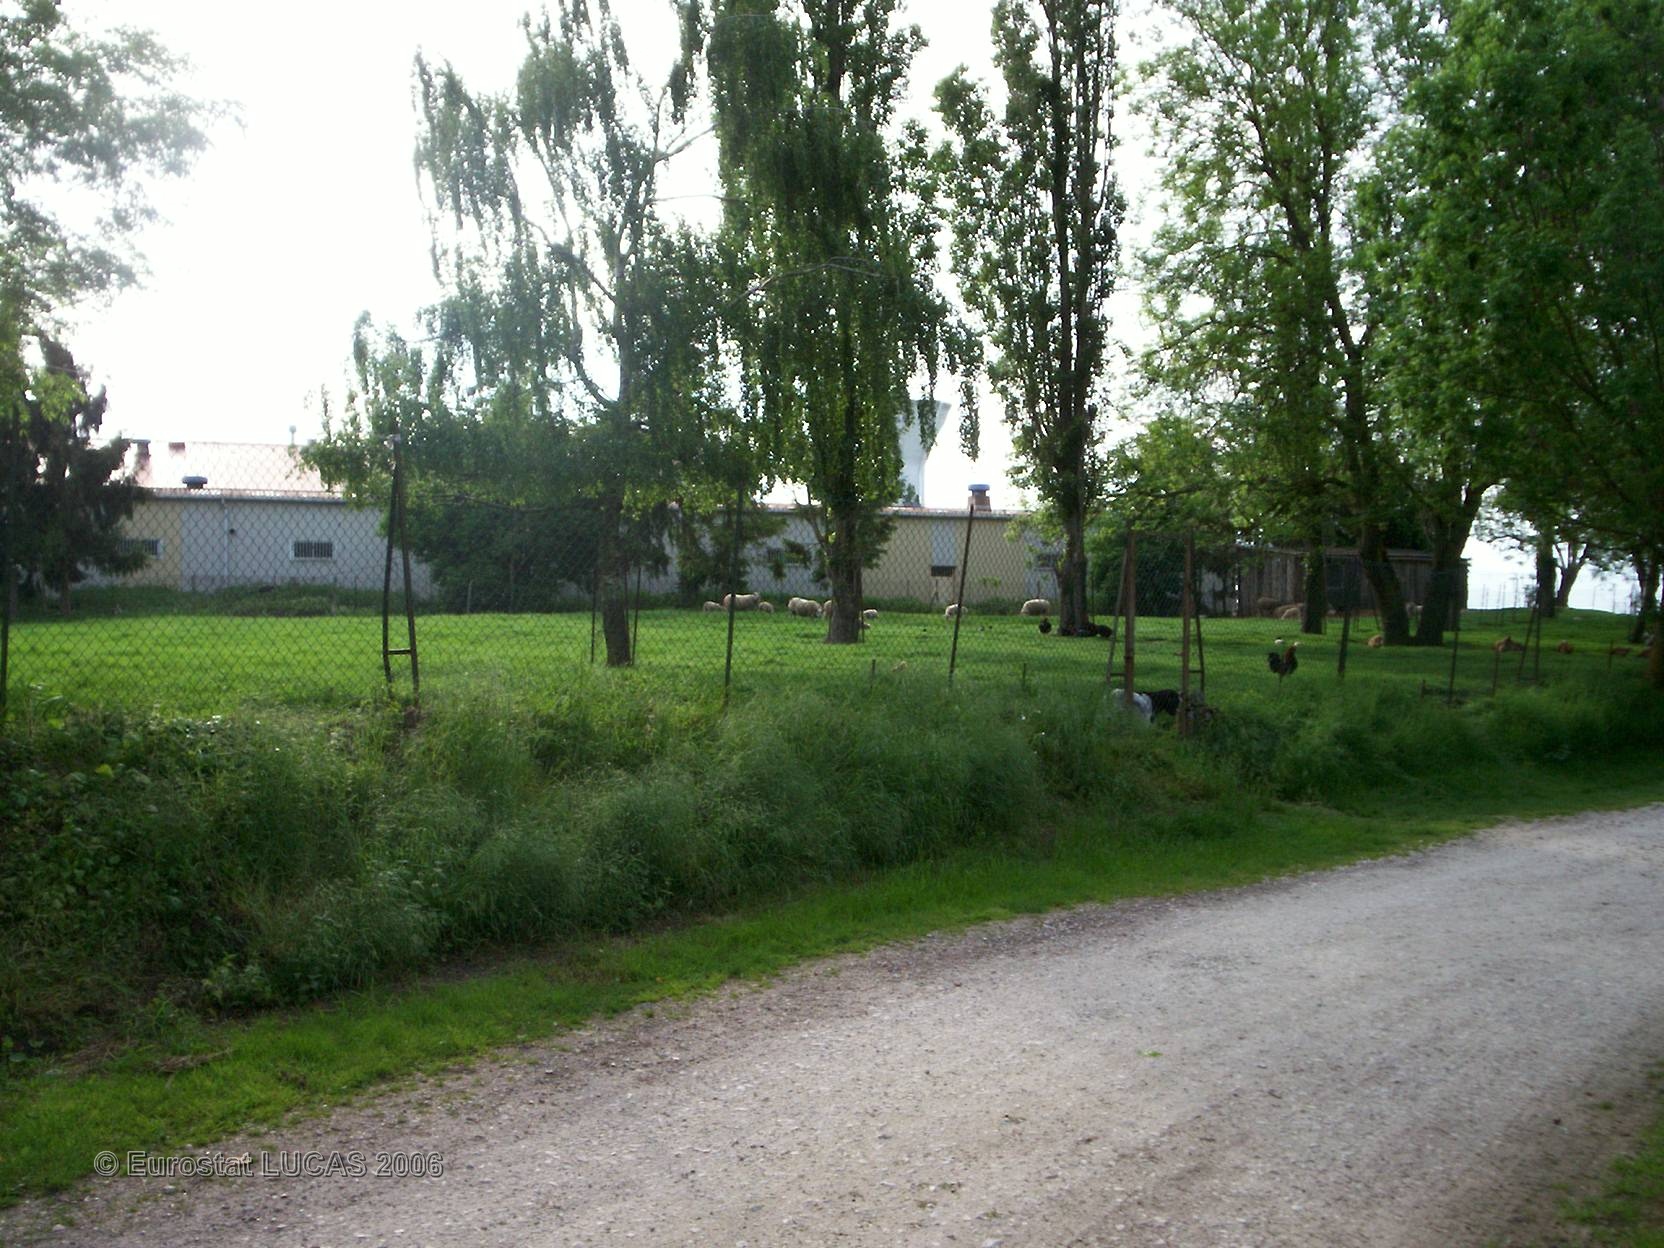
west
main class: Grassland
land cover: Grassland with sparse tree/shrub cover
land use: Residential
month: May
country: FR
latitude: 48.5854
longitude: 2.8195
